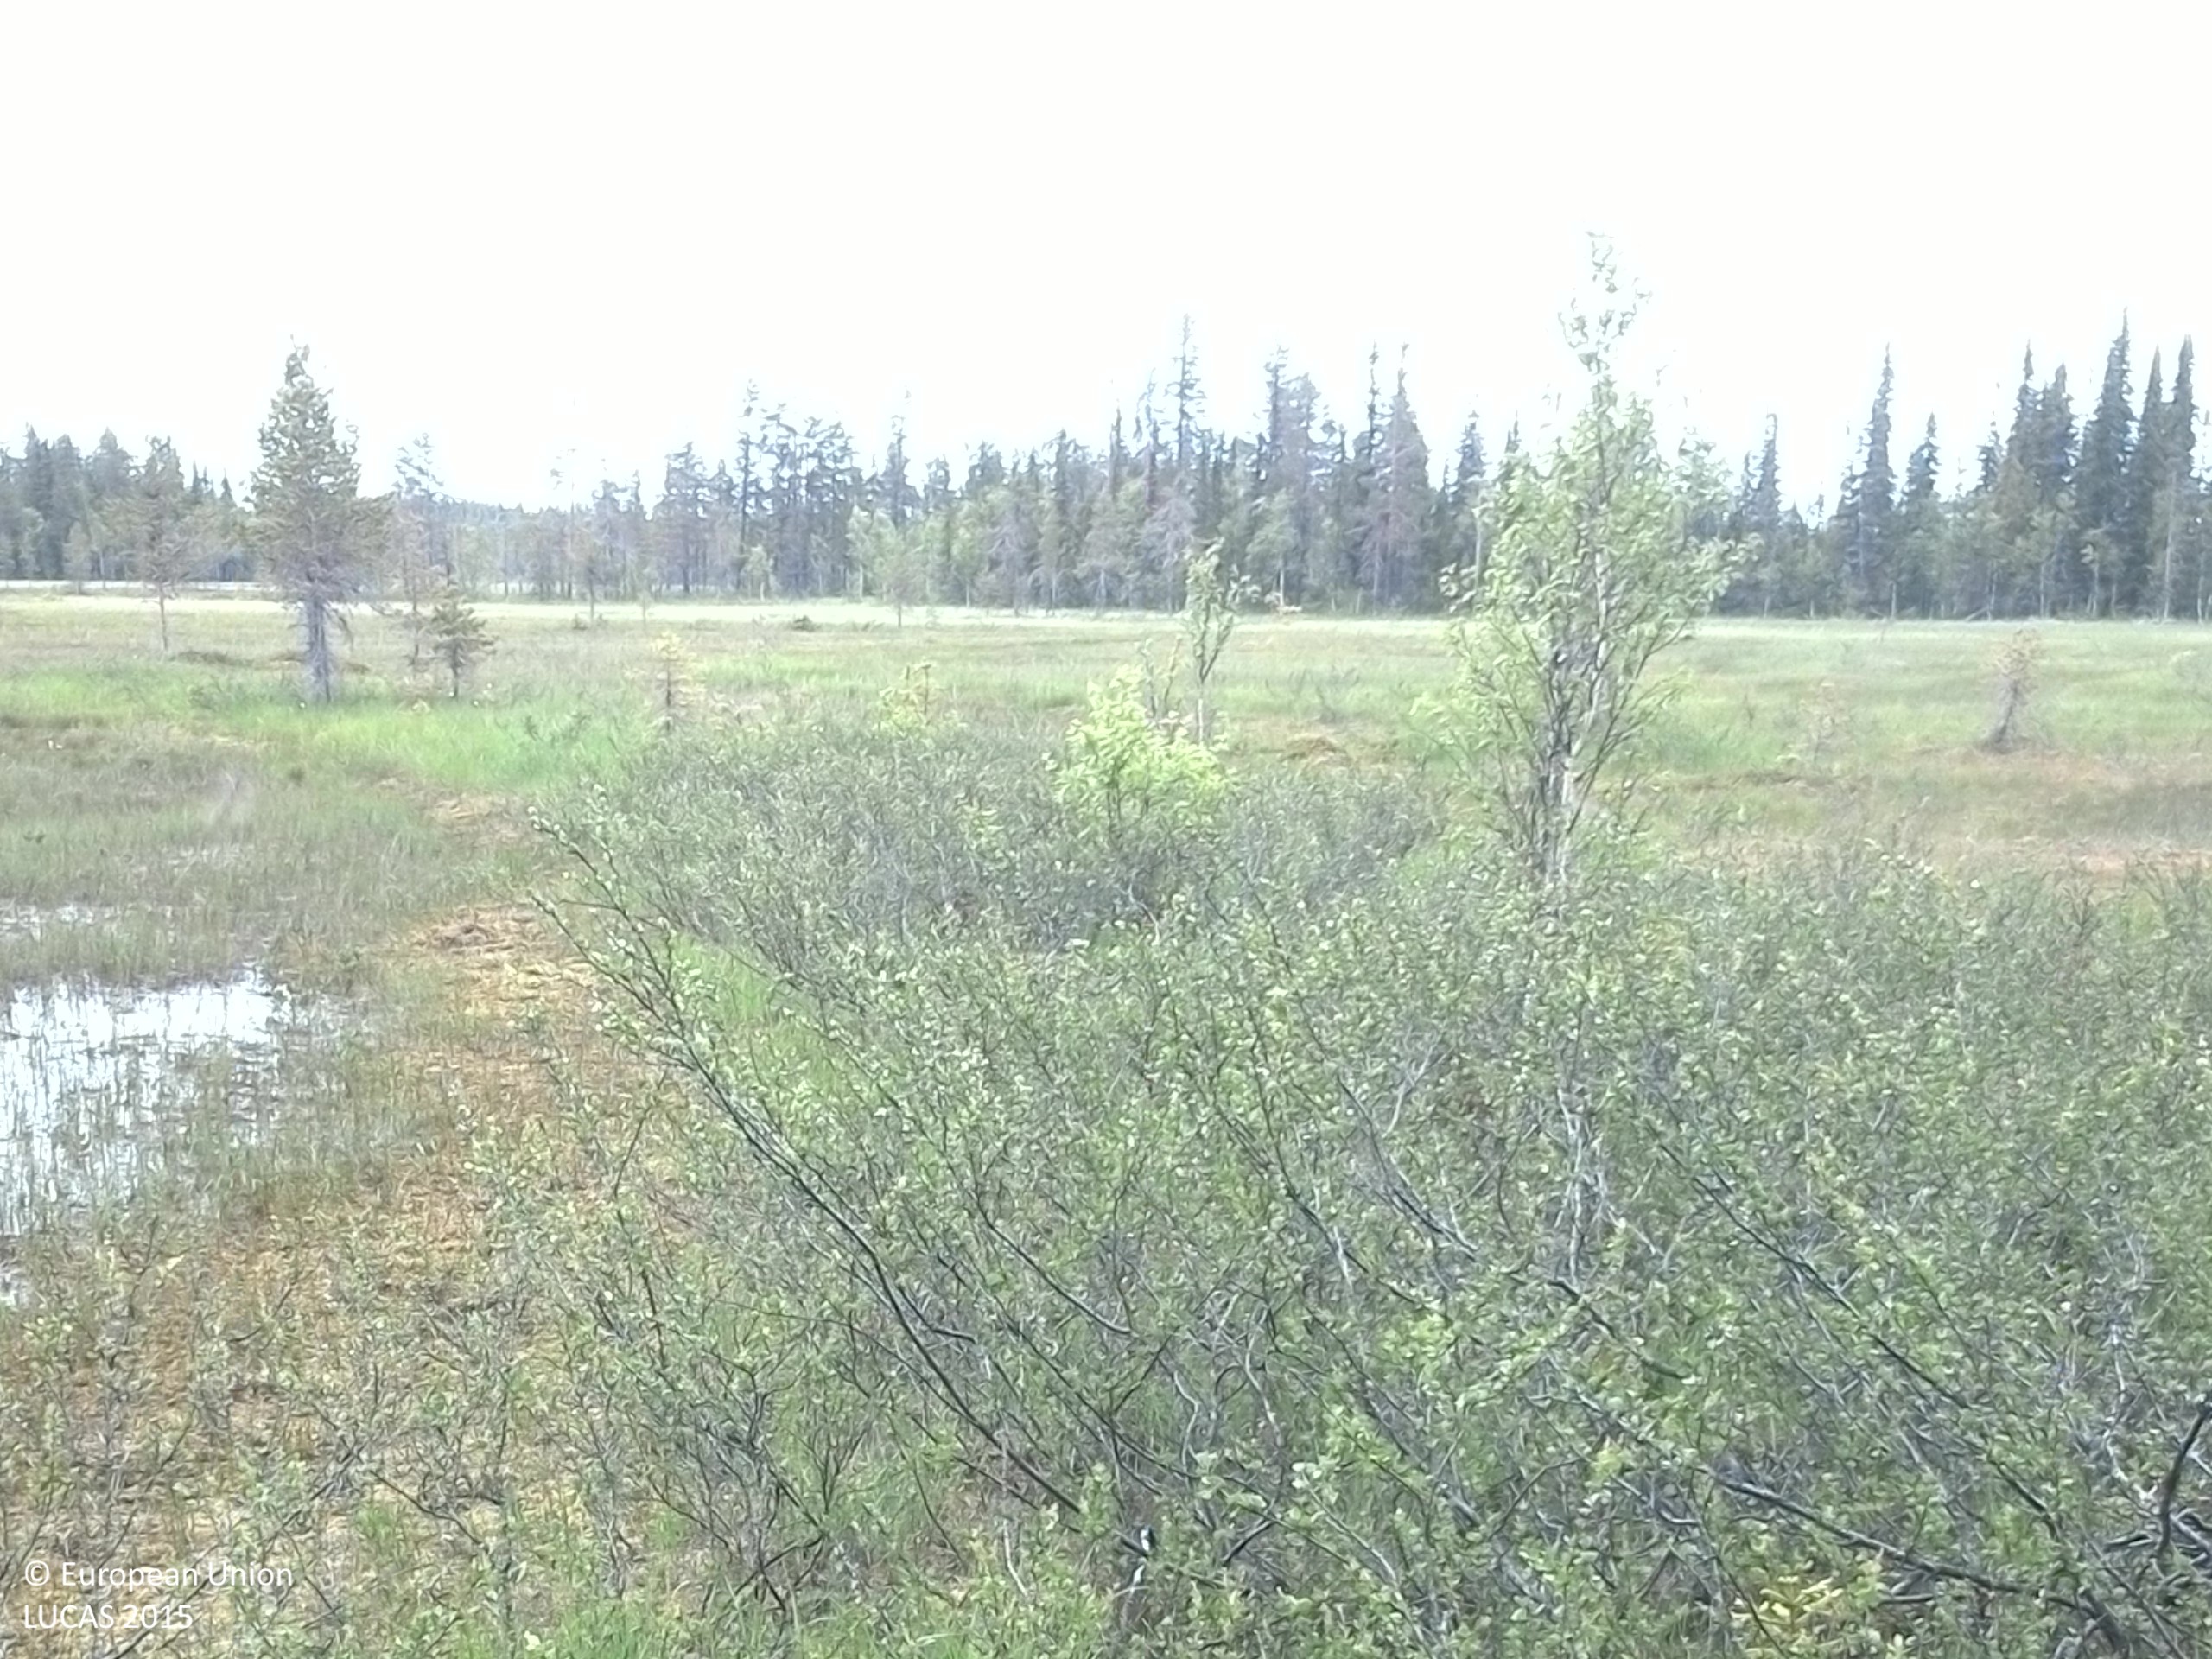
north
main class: Shrubland
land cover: Shrubland with sparse tree cover
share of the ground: 50 - 75 %
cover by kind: shrubs 70 %, herbaceous plants 15 %, lichens and mosses 10 %, broadleaved forest trees 5 %
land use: Semi-natural and natural areas not in use
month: July
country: SE
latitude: 64.3755
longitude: 16.4554
